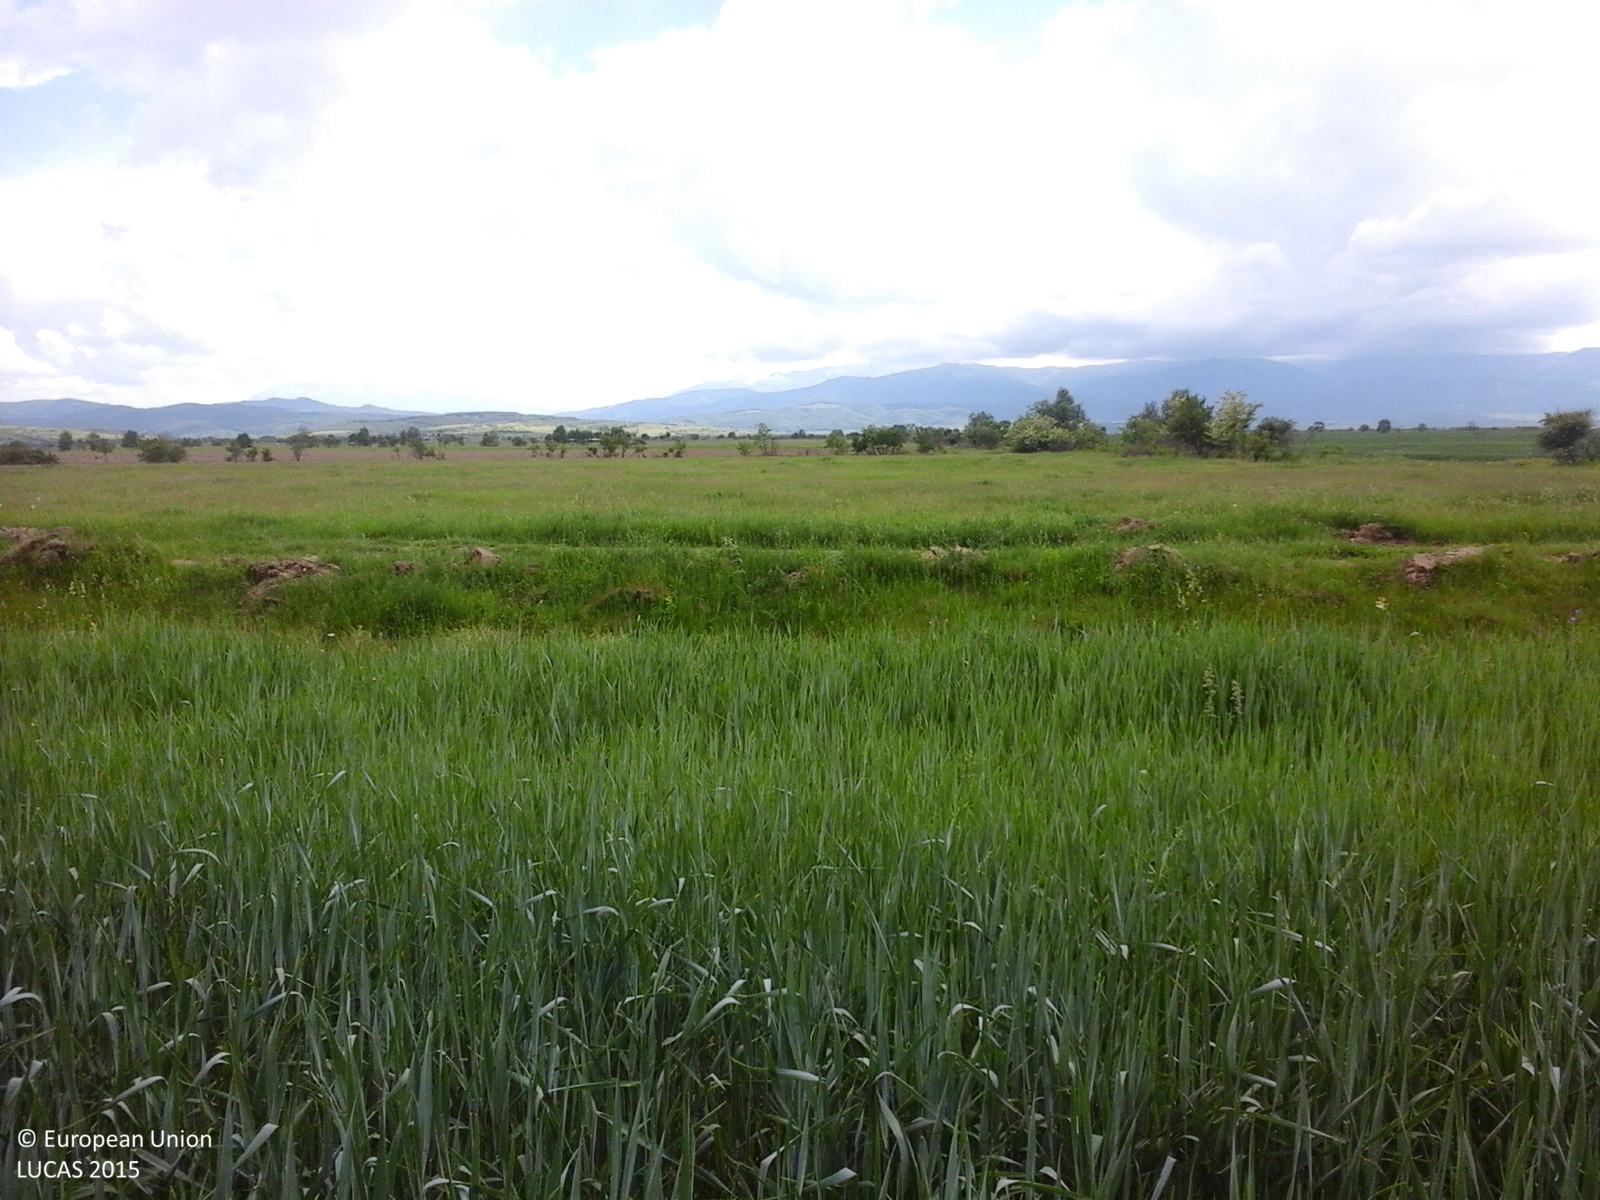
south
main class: Cropland
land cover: Rye
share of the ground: > 75 %
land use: Agriculture (excluding fallow land and kitchen gardens)
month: May
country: RO
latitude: 45.8291
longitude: 25.1702
